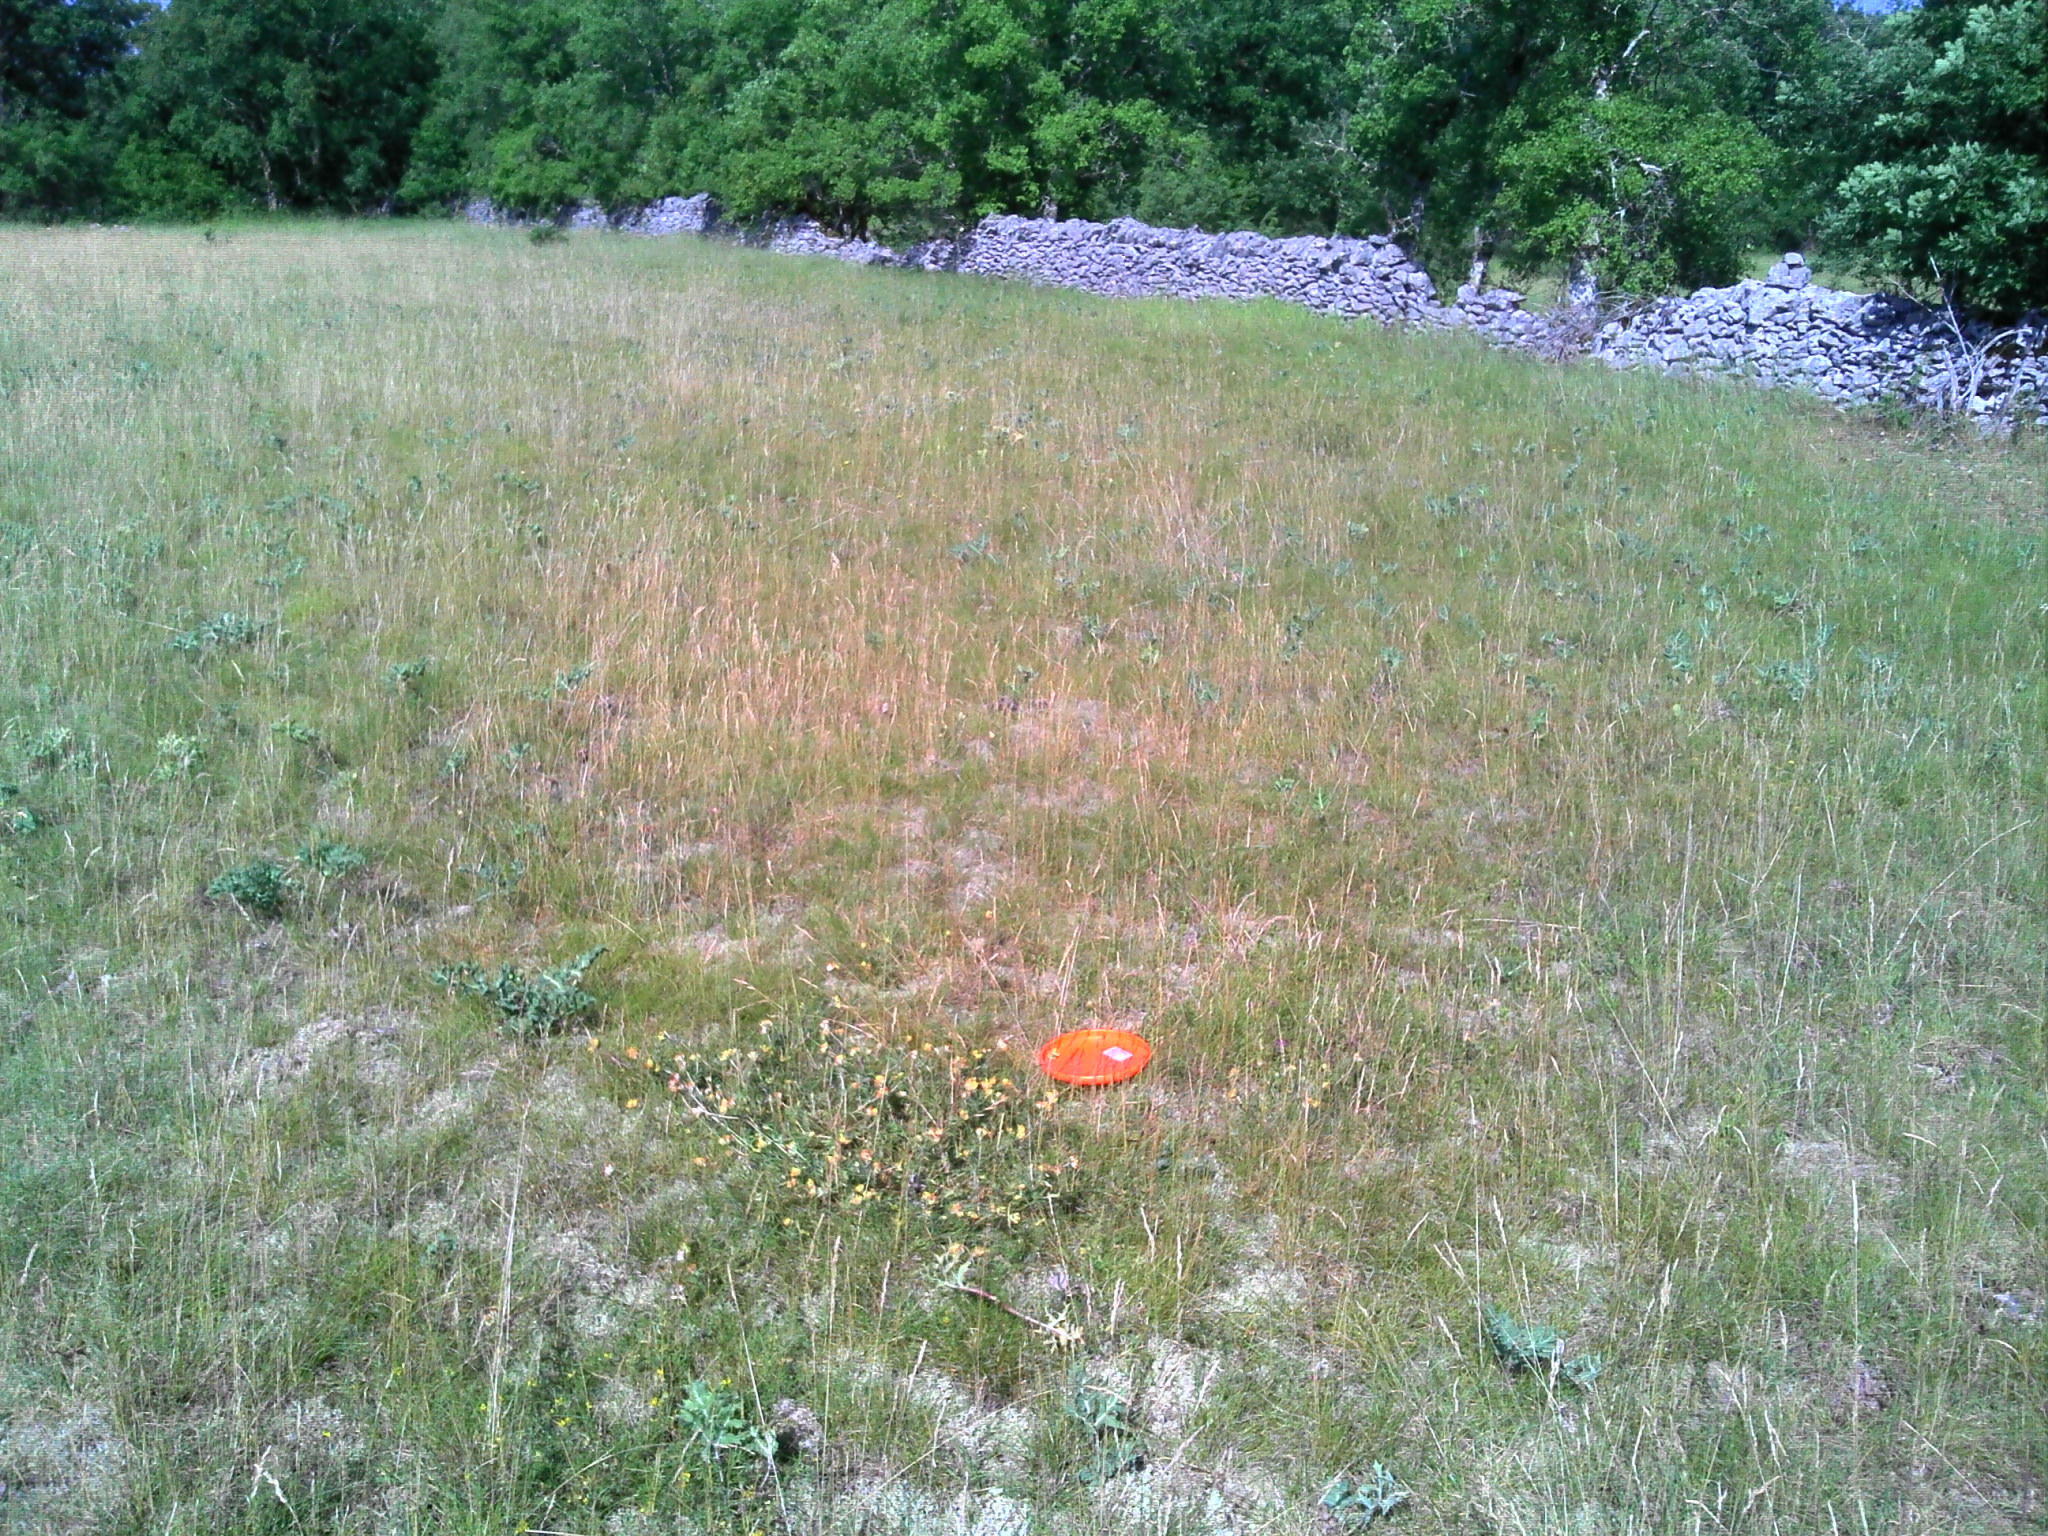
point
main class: Grassland
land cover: Grassland without tree/shrub cover
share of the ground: > 75 %
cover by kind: herbaceous plants 70 %, lichens and mosses 30 %
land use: Agriculture (excluding fallow land and kitchen gardens)
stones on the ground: 10 - 25 %
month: June
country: FR
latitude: 44.6589
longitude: 1.7889
